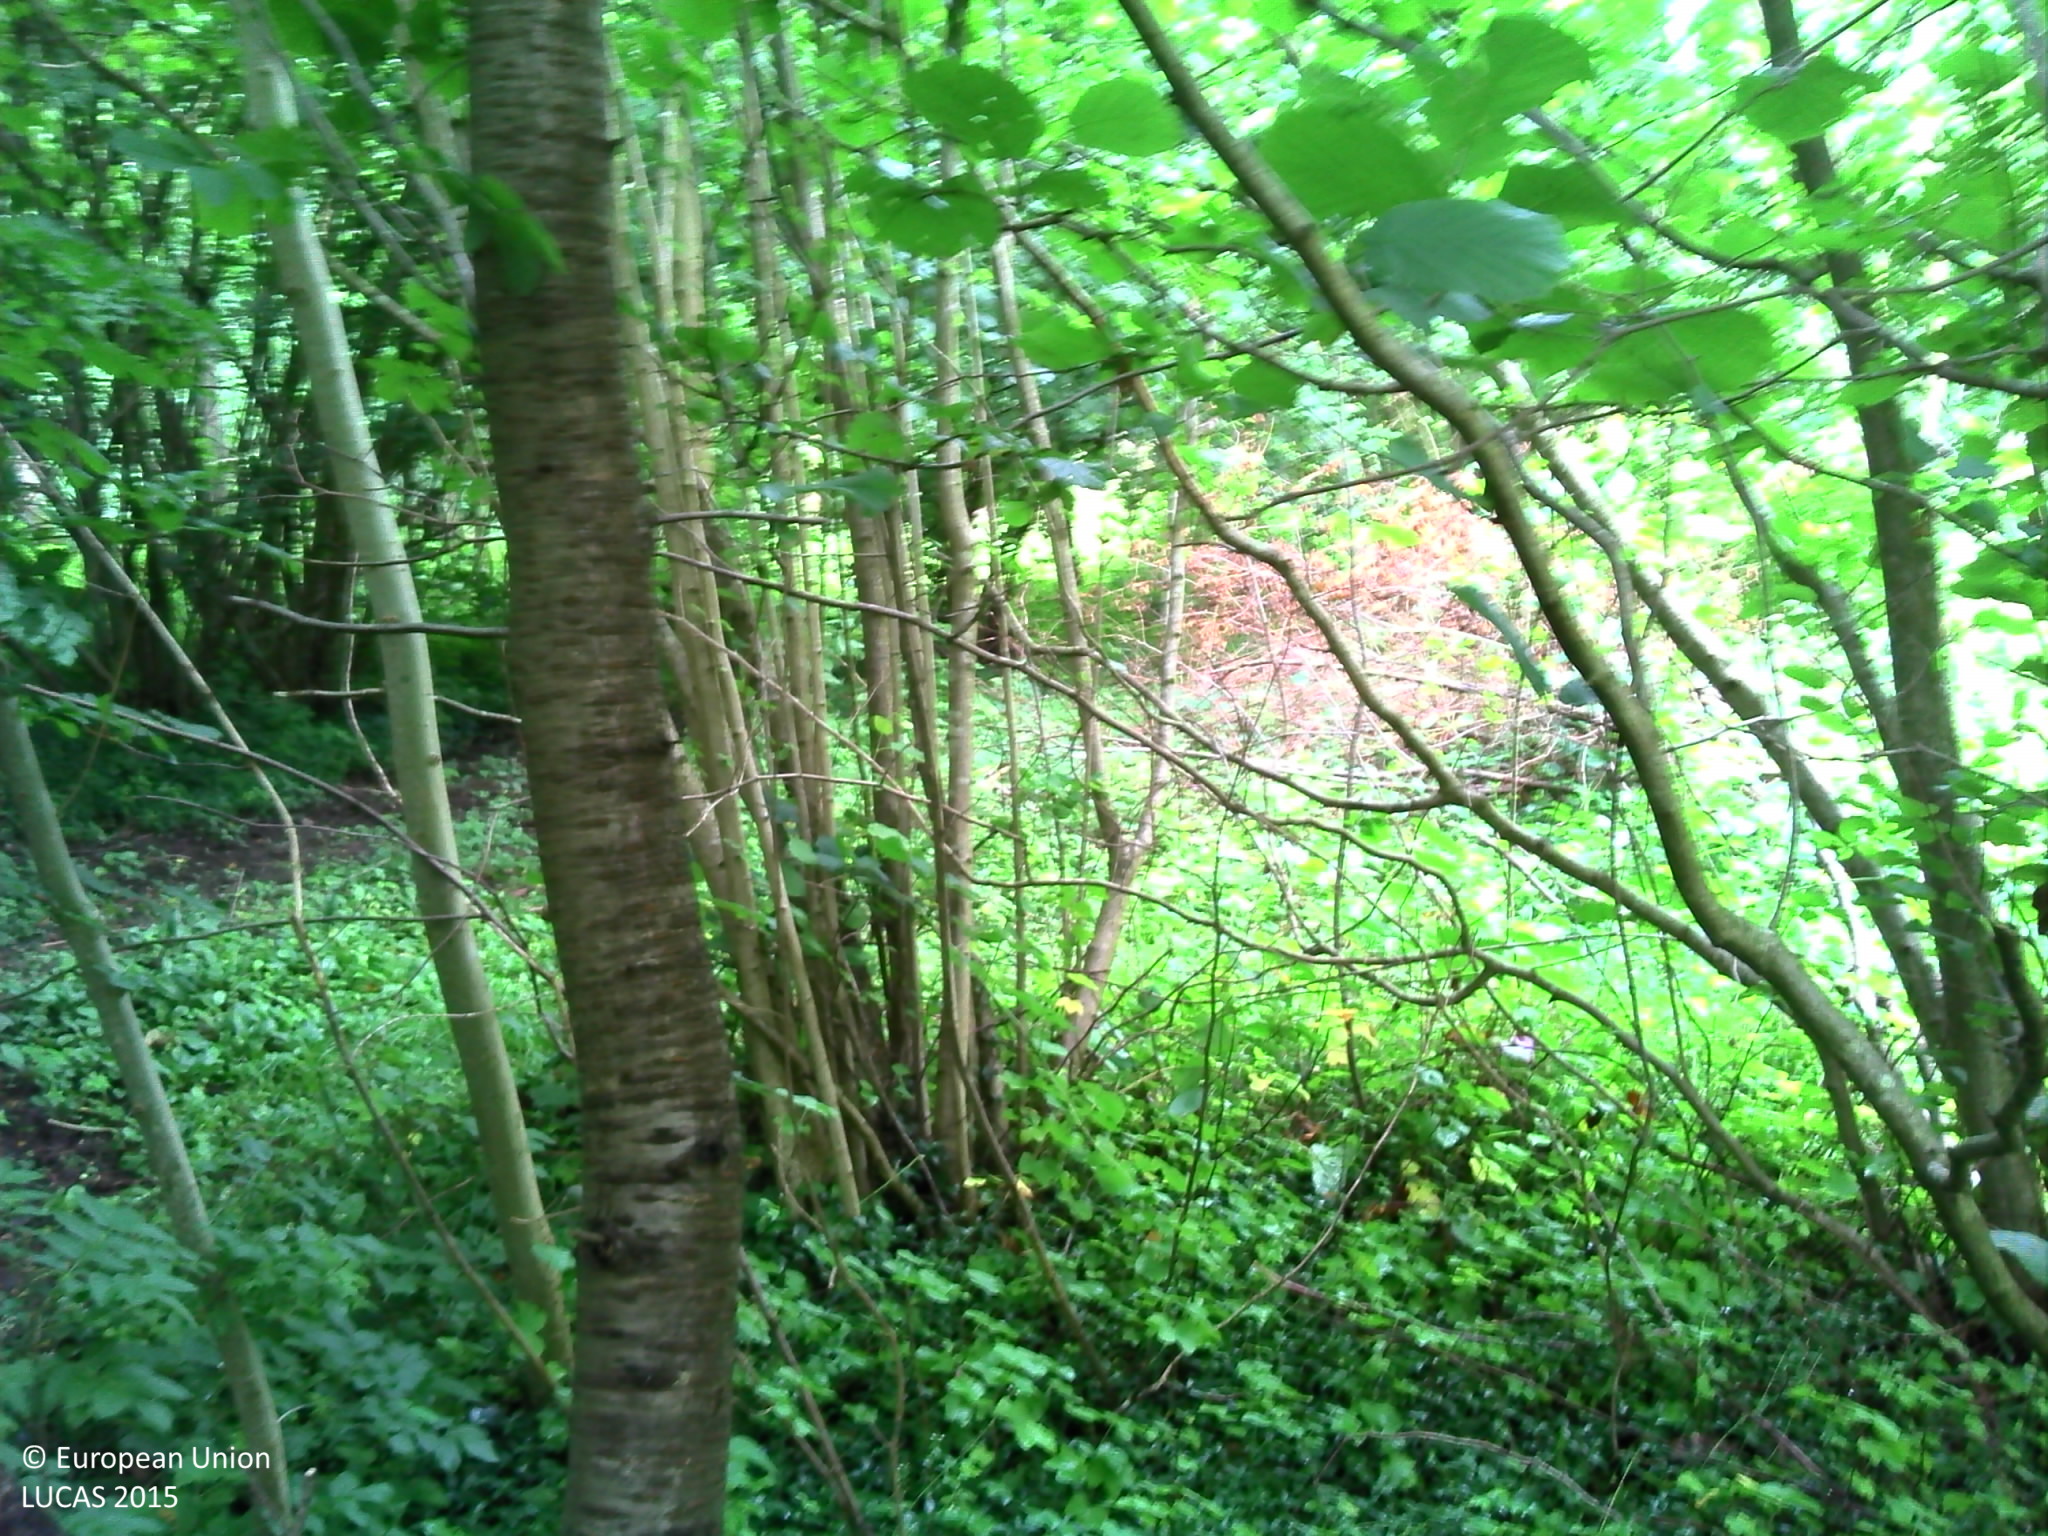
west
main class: Woodland
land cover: Broadleaved woodland
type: mesophytic deciduous forest
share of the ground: > 75 %
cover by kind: broadleaved forest trees 80 %, herbaceous plants 20 %
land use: Forestry
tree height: > 5 m
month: July
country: FR
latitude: 50.8278
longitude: 2.0483
